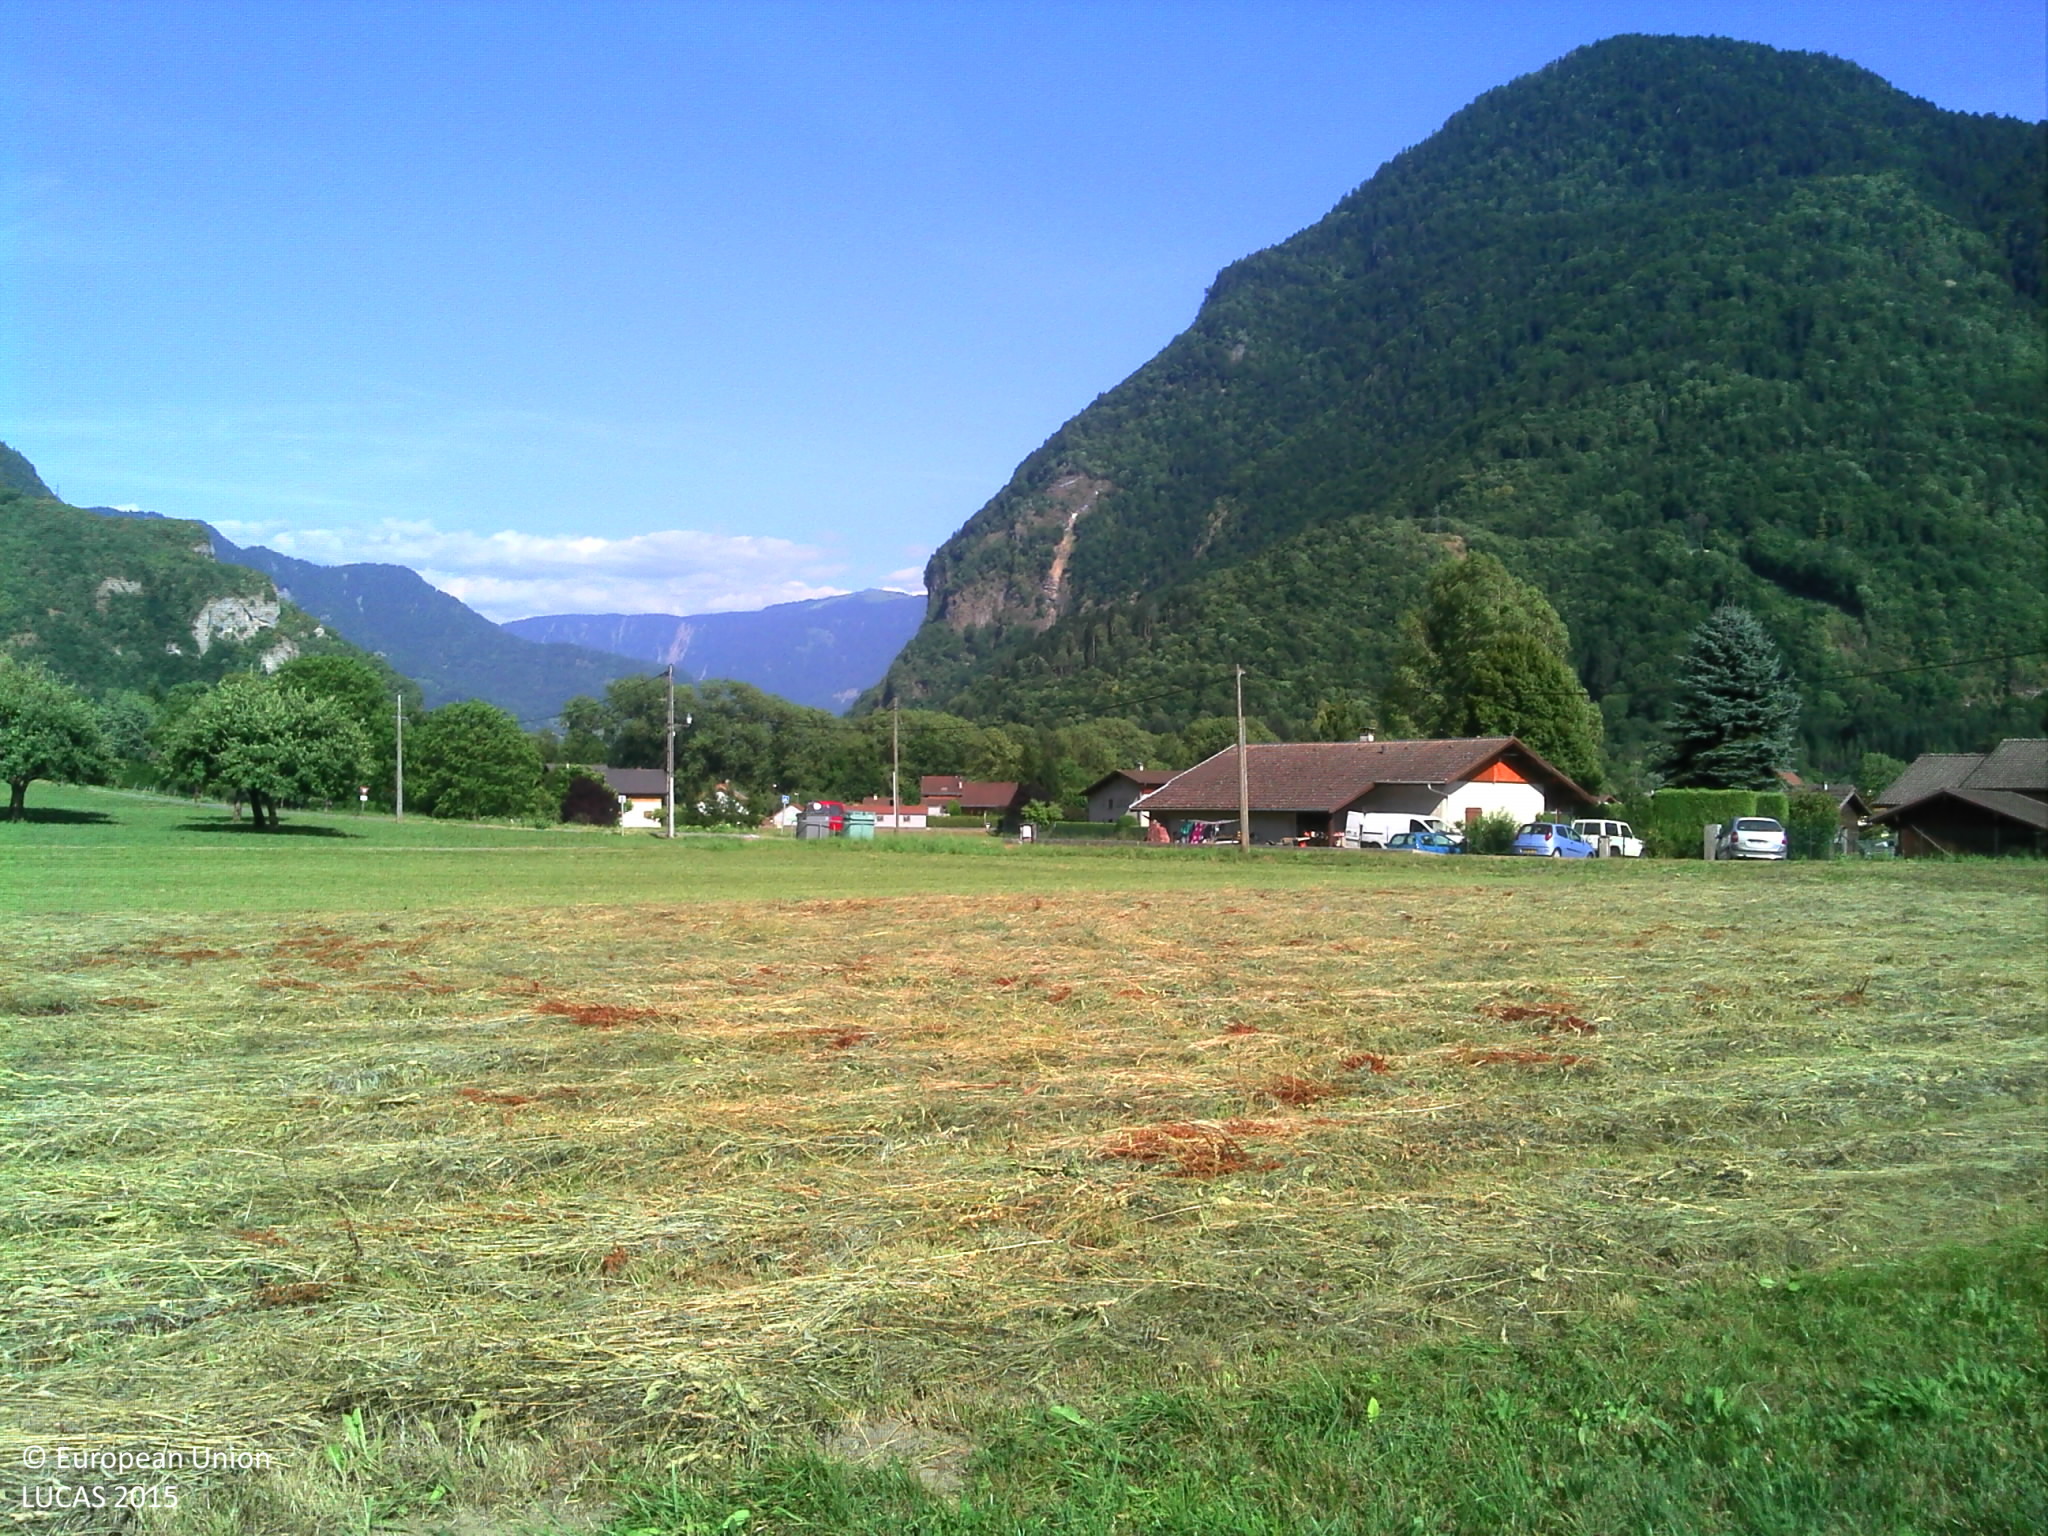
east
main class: Grassland
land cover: Grassland without tree/shrub cover
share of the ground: > 75 %
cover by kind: herbaceous plants 100 %
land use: Agriculture (excluding fallow land and kitchen gardens)
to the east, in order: Grassland without tree/shrub cover; Other bare soil; Grassland without tree/shrub cover; Paved roads, cycling and walking lanes; Grassland with sparse tree/shrub cover; Electric lines; Paved roads, cycling and walking lanes; Grassland without tree/shrub cover; Fences; Grassland with sparse tree/shrub cover; Other fresh vegetables; Grassland with sparse tree/shrub cover; Paved roads, cycling and walking lanes
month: July
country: FR
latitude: 45.7657
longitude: 6.3396
